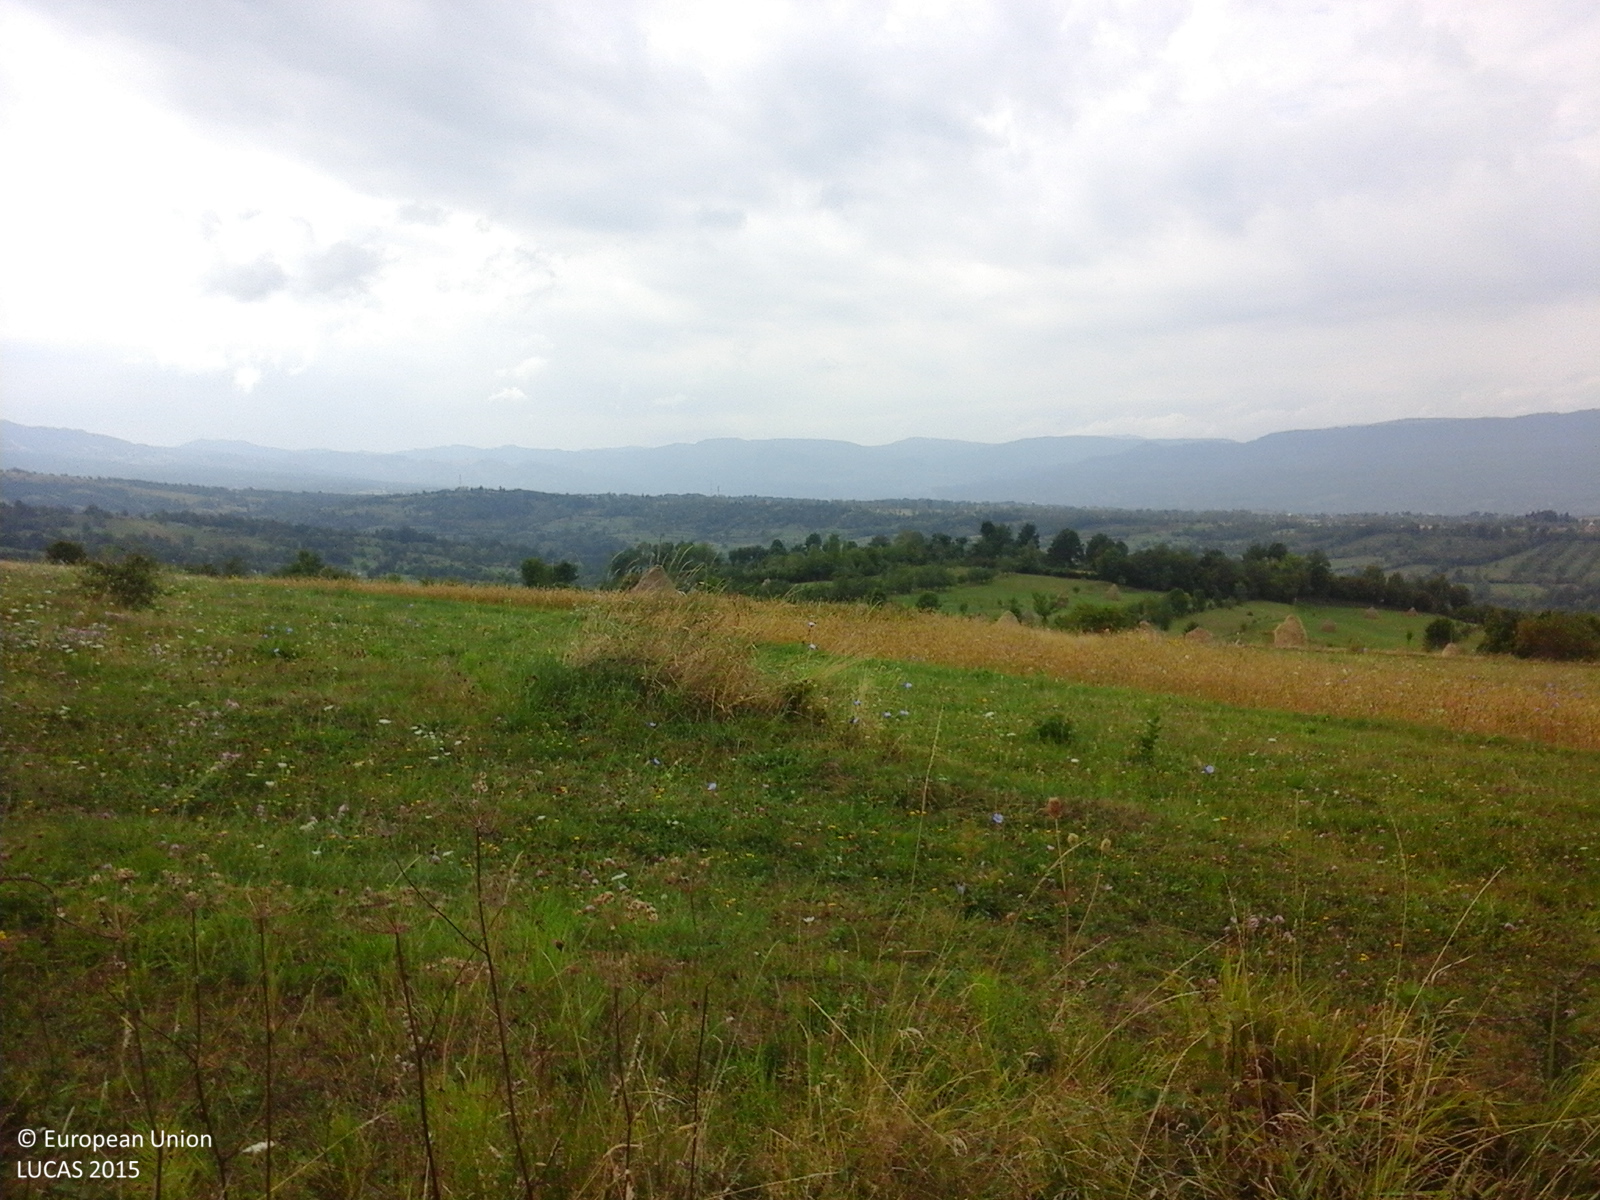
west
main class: Grassland
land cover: Spontaneously vegetated surfaces
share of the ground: > 75 %
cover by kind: herbaceous plants 100 %
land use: Agriculture (excluding fallow land and kitchen gardens)
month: September
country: RO
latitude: 47.7662
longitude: 23.9740
